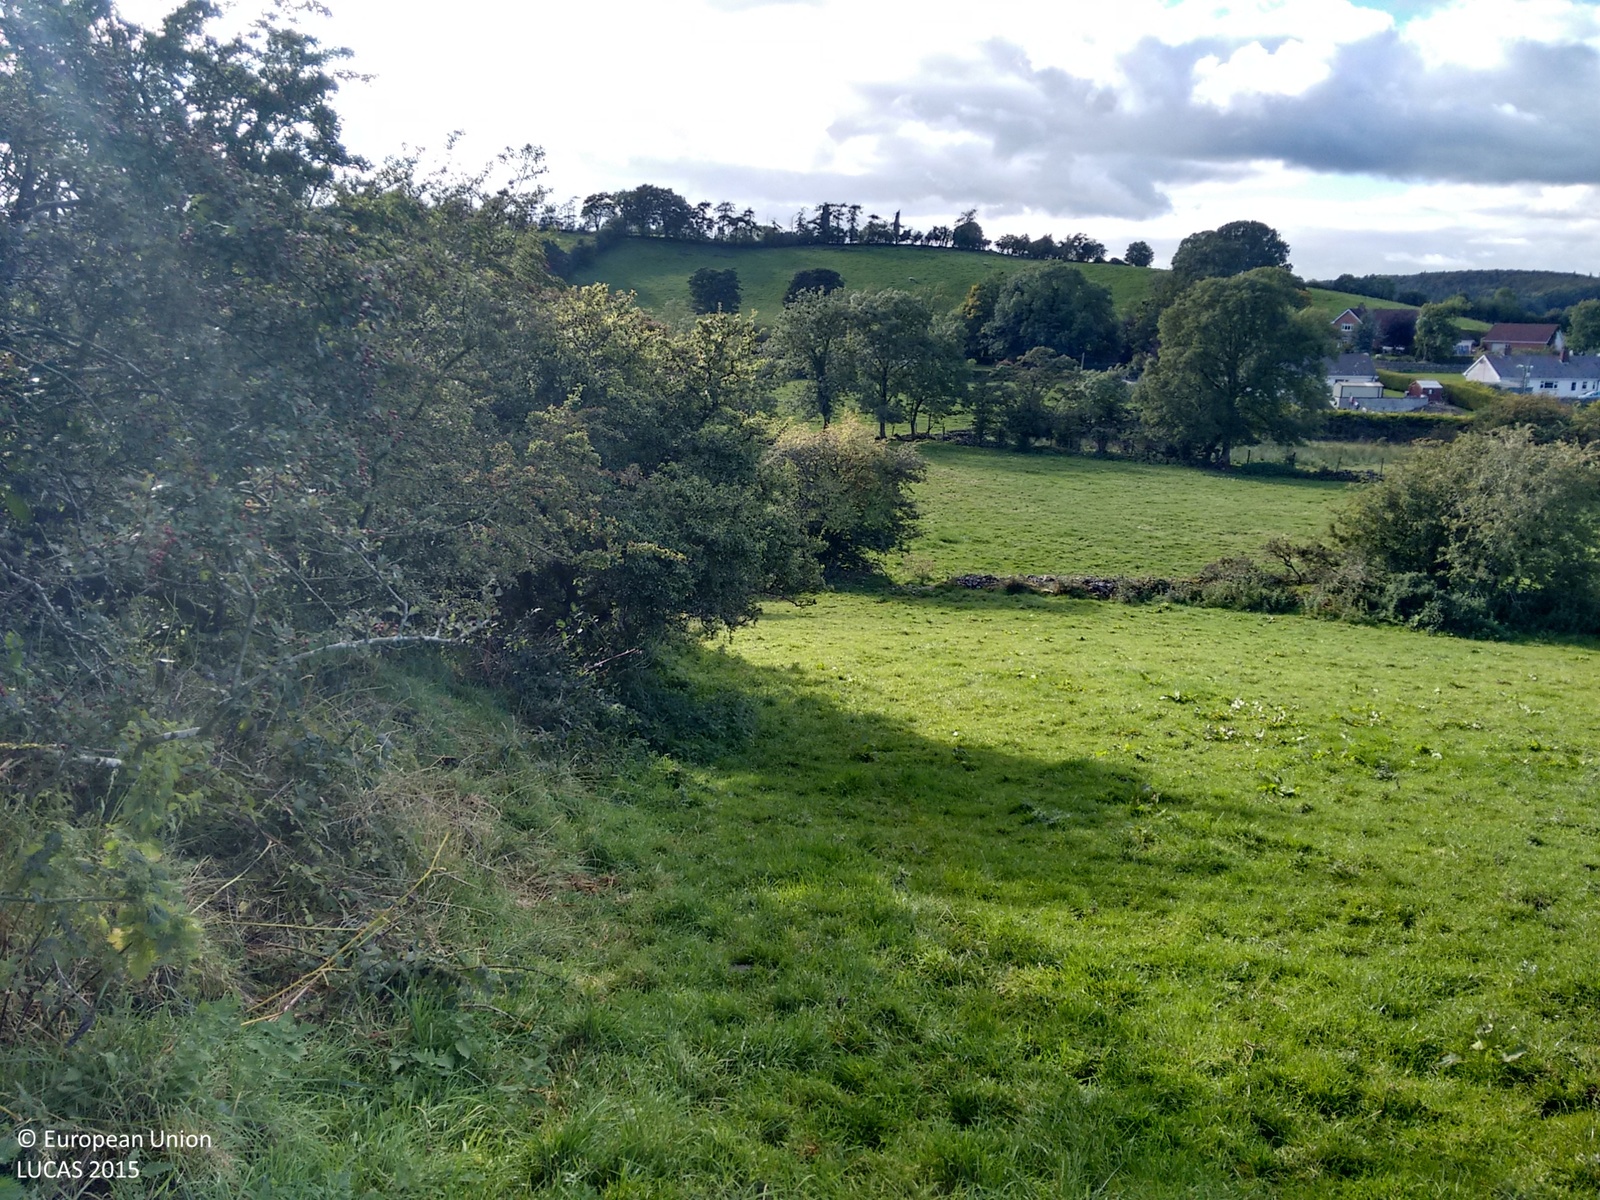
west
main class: Grassland
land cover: Grassland without tree/shrub cover
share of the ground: > 75 %
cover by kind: herbaceous plants 100 %
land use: Agriculture (excluding fallow land and kitchen gardens)
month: September
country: IE
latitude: 54.2168
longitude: -6.9622
